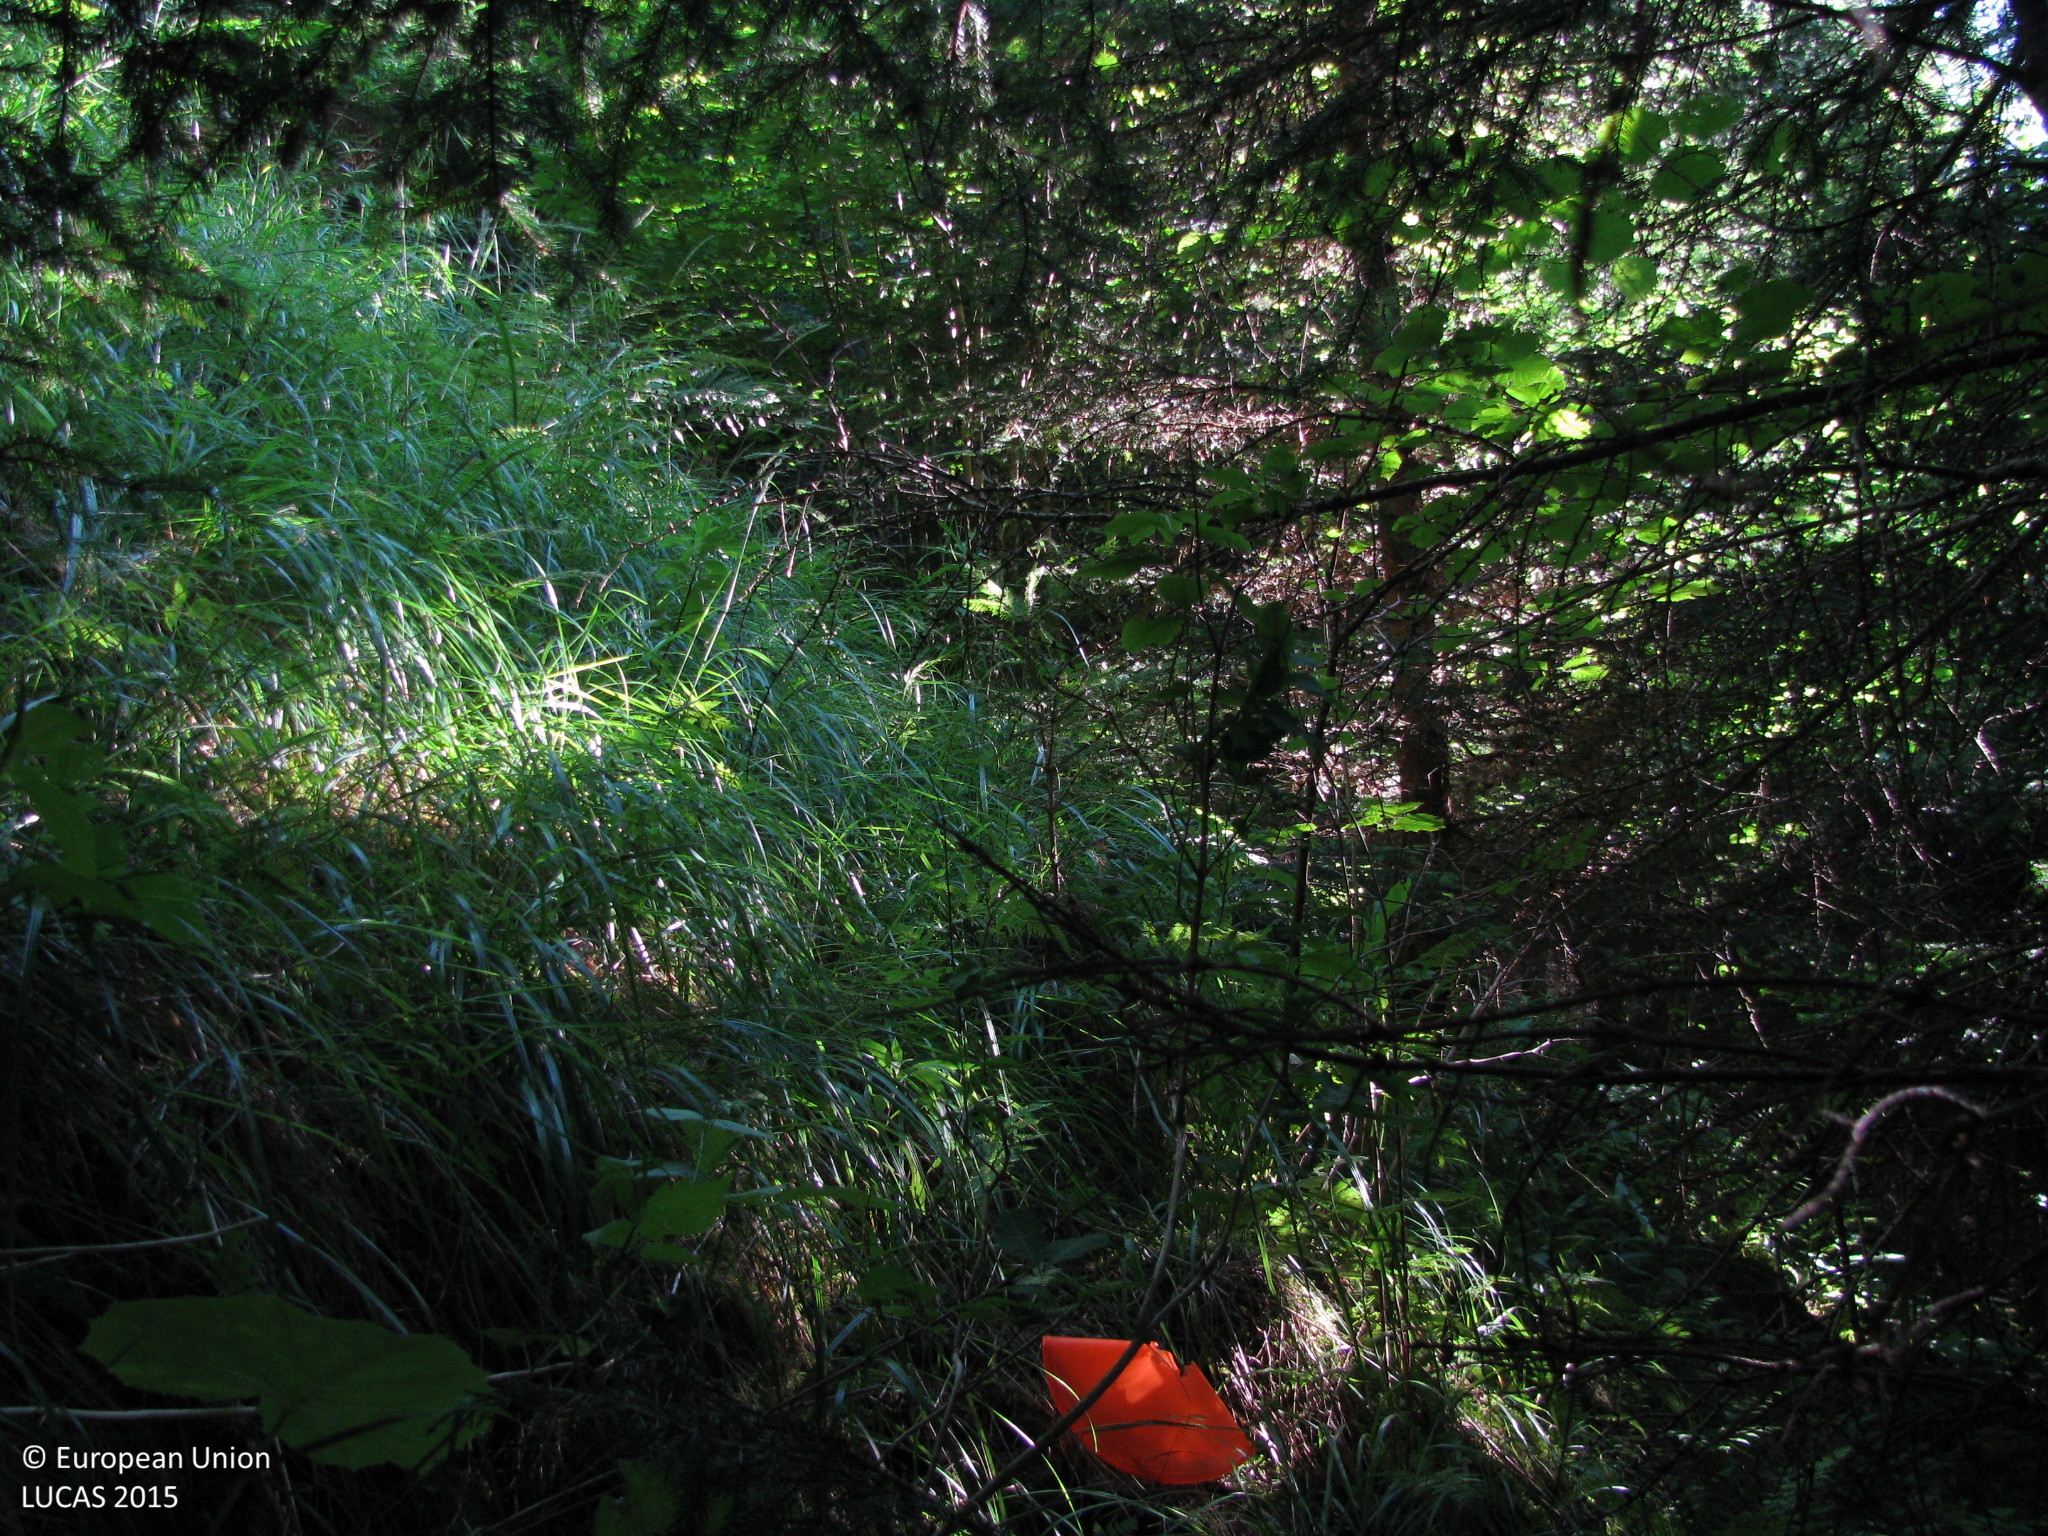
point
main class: Woodland
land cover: Spruce dominated coniferous woodland
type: alpine coniferous forest
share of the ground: > 75 %
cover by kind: coniferous forest trees 80 %, herbaceous plants 15 %, shrubs 5 %
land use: Forestry
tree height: > 5 m
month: July
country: AT
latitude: 47.2467
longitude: 14.9538
